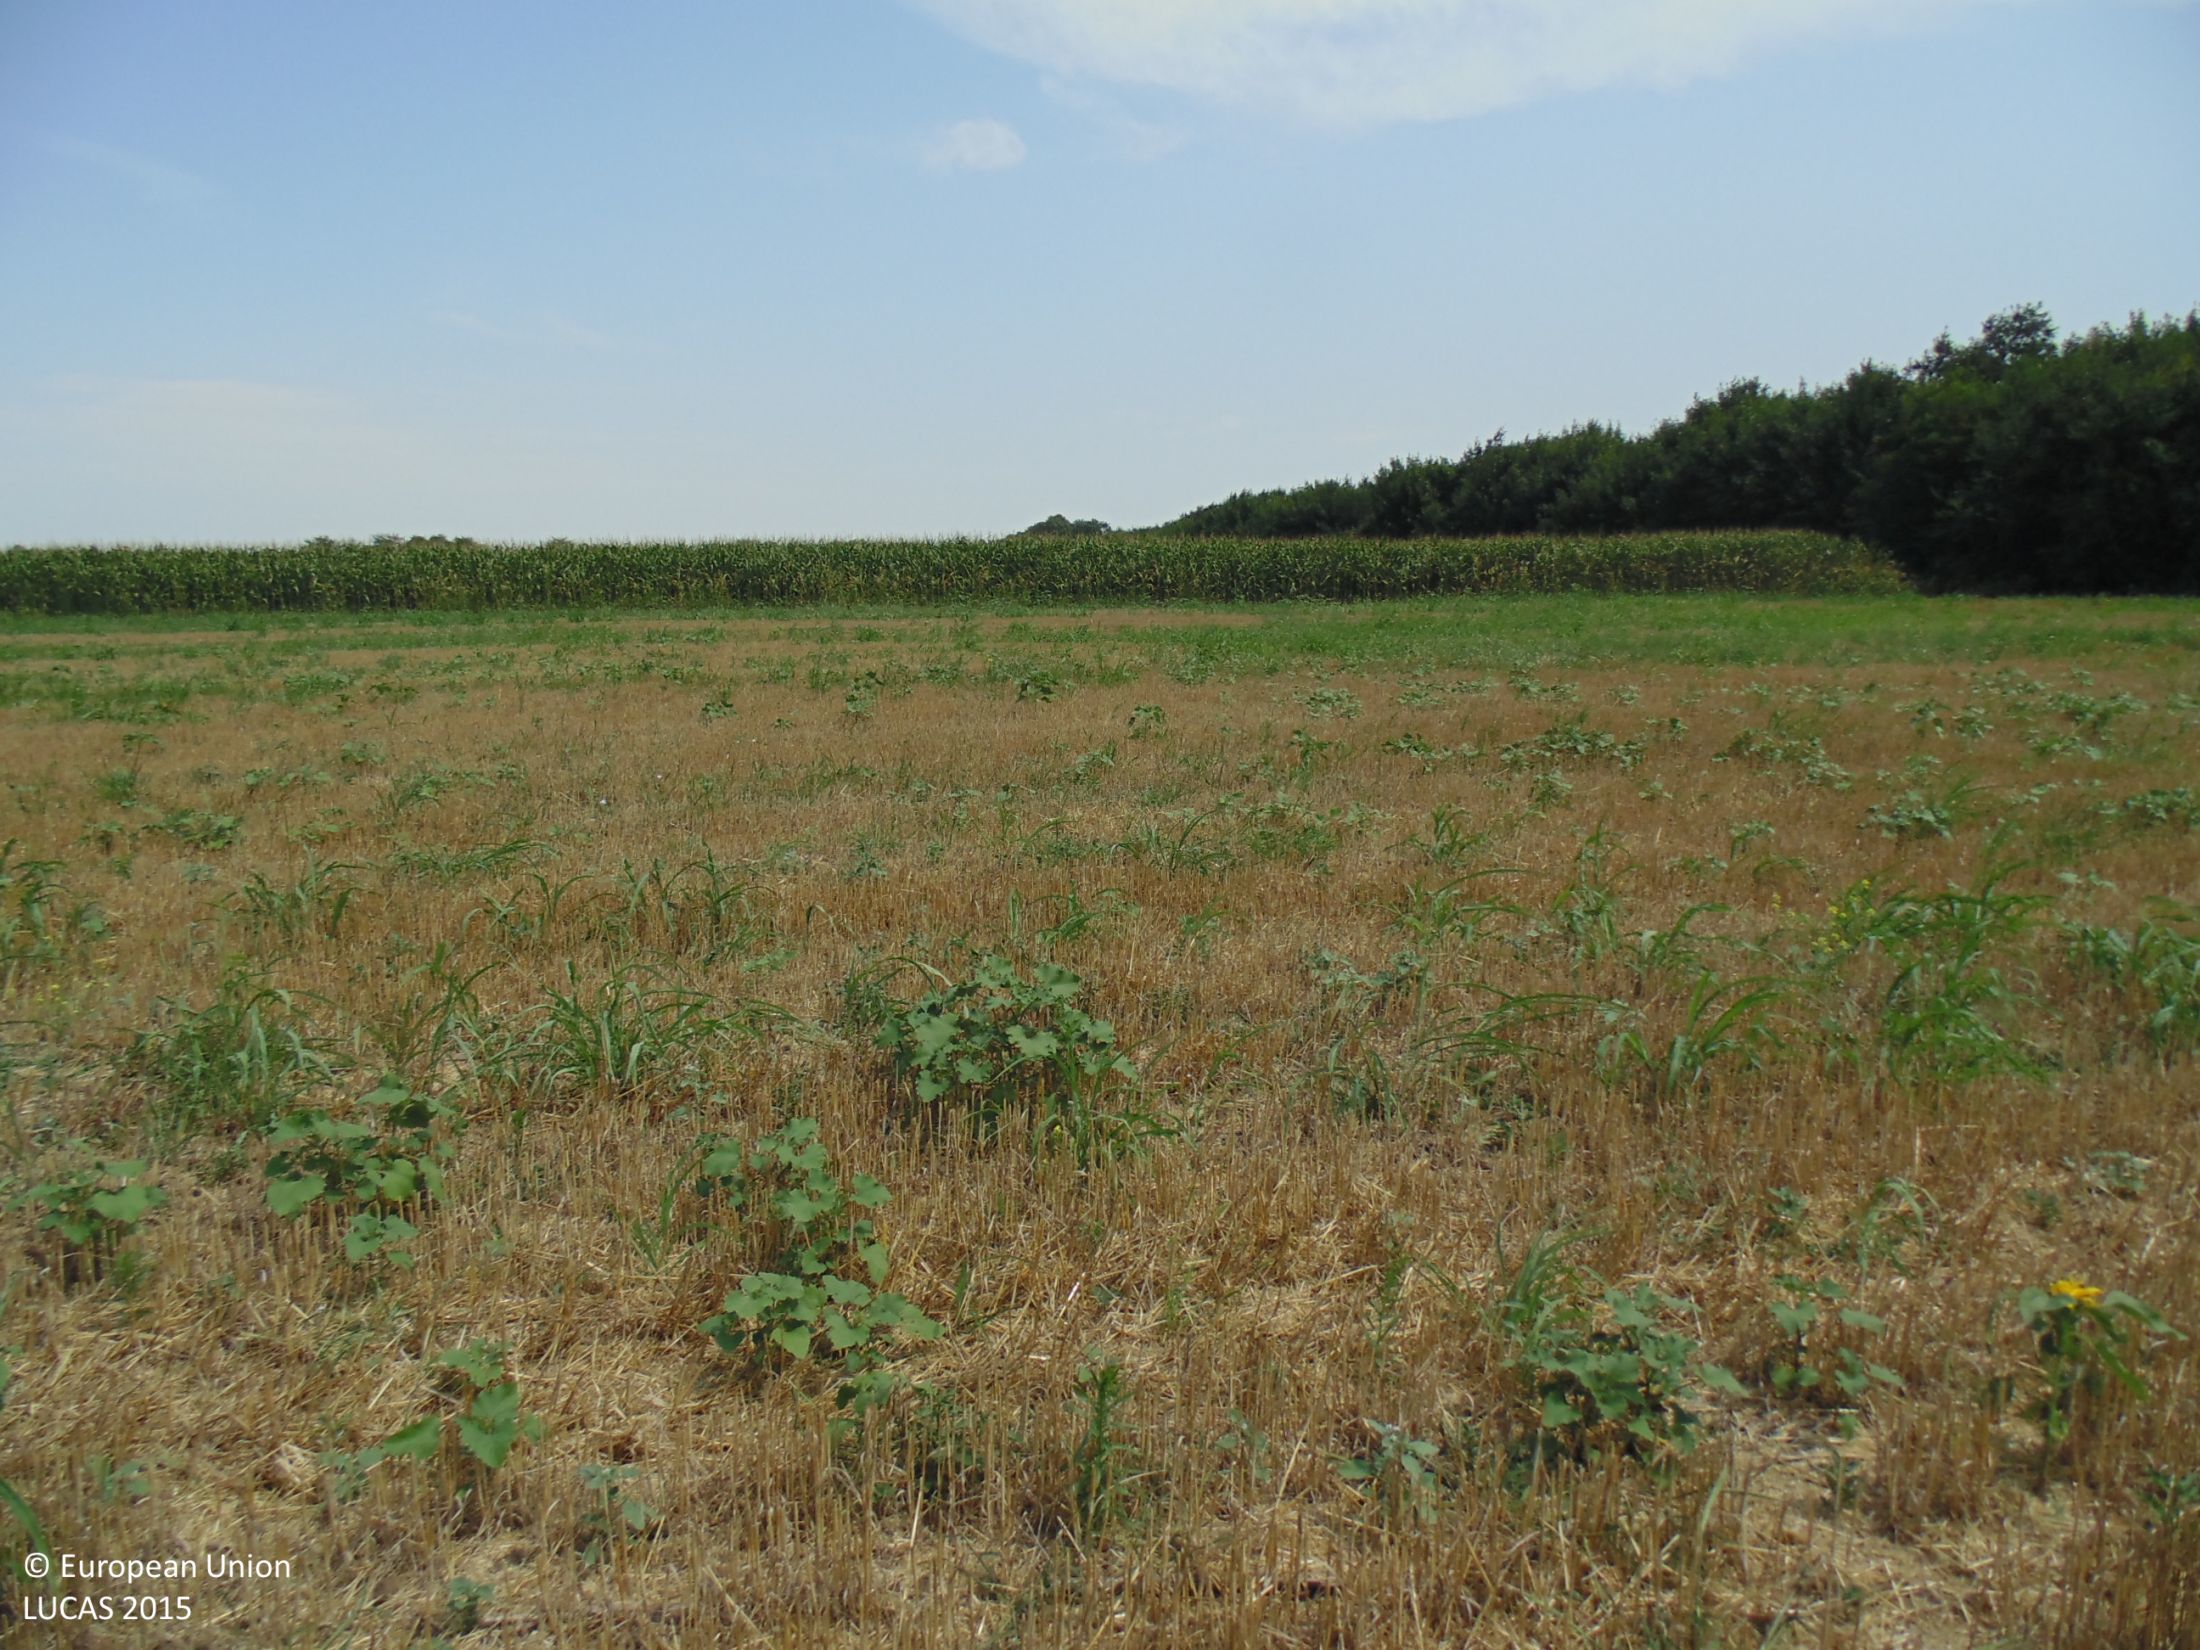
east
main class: Cropland
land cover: Common wheat
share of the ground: 25 - 50 %
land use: Agriculture (excluding fallow land and kitchen gardens)
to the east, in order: Common wheat; Grass margins; Maize
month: August
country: BG
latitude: 43.7443
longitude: 28.1720
